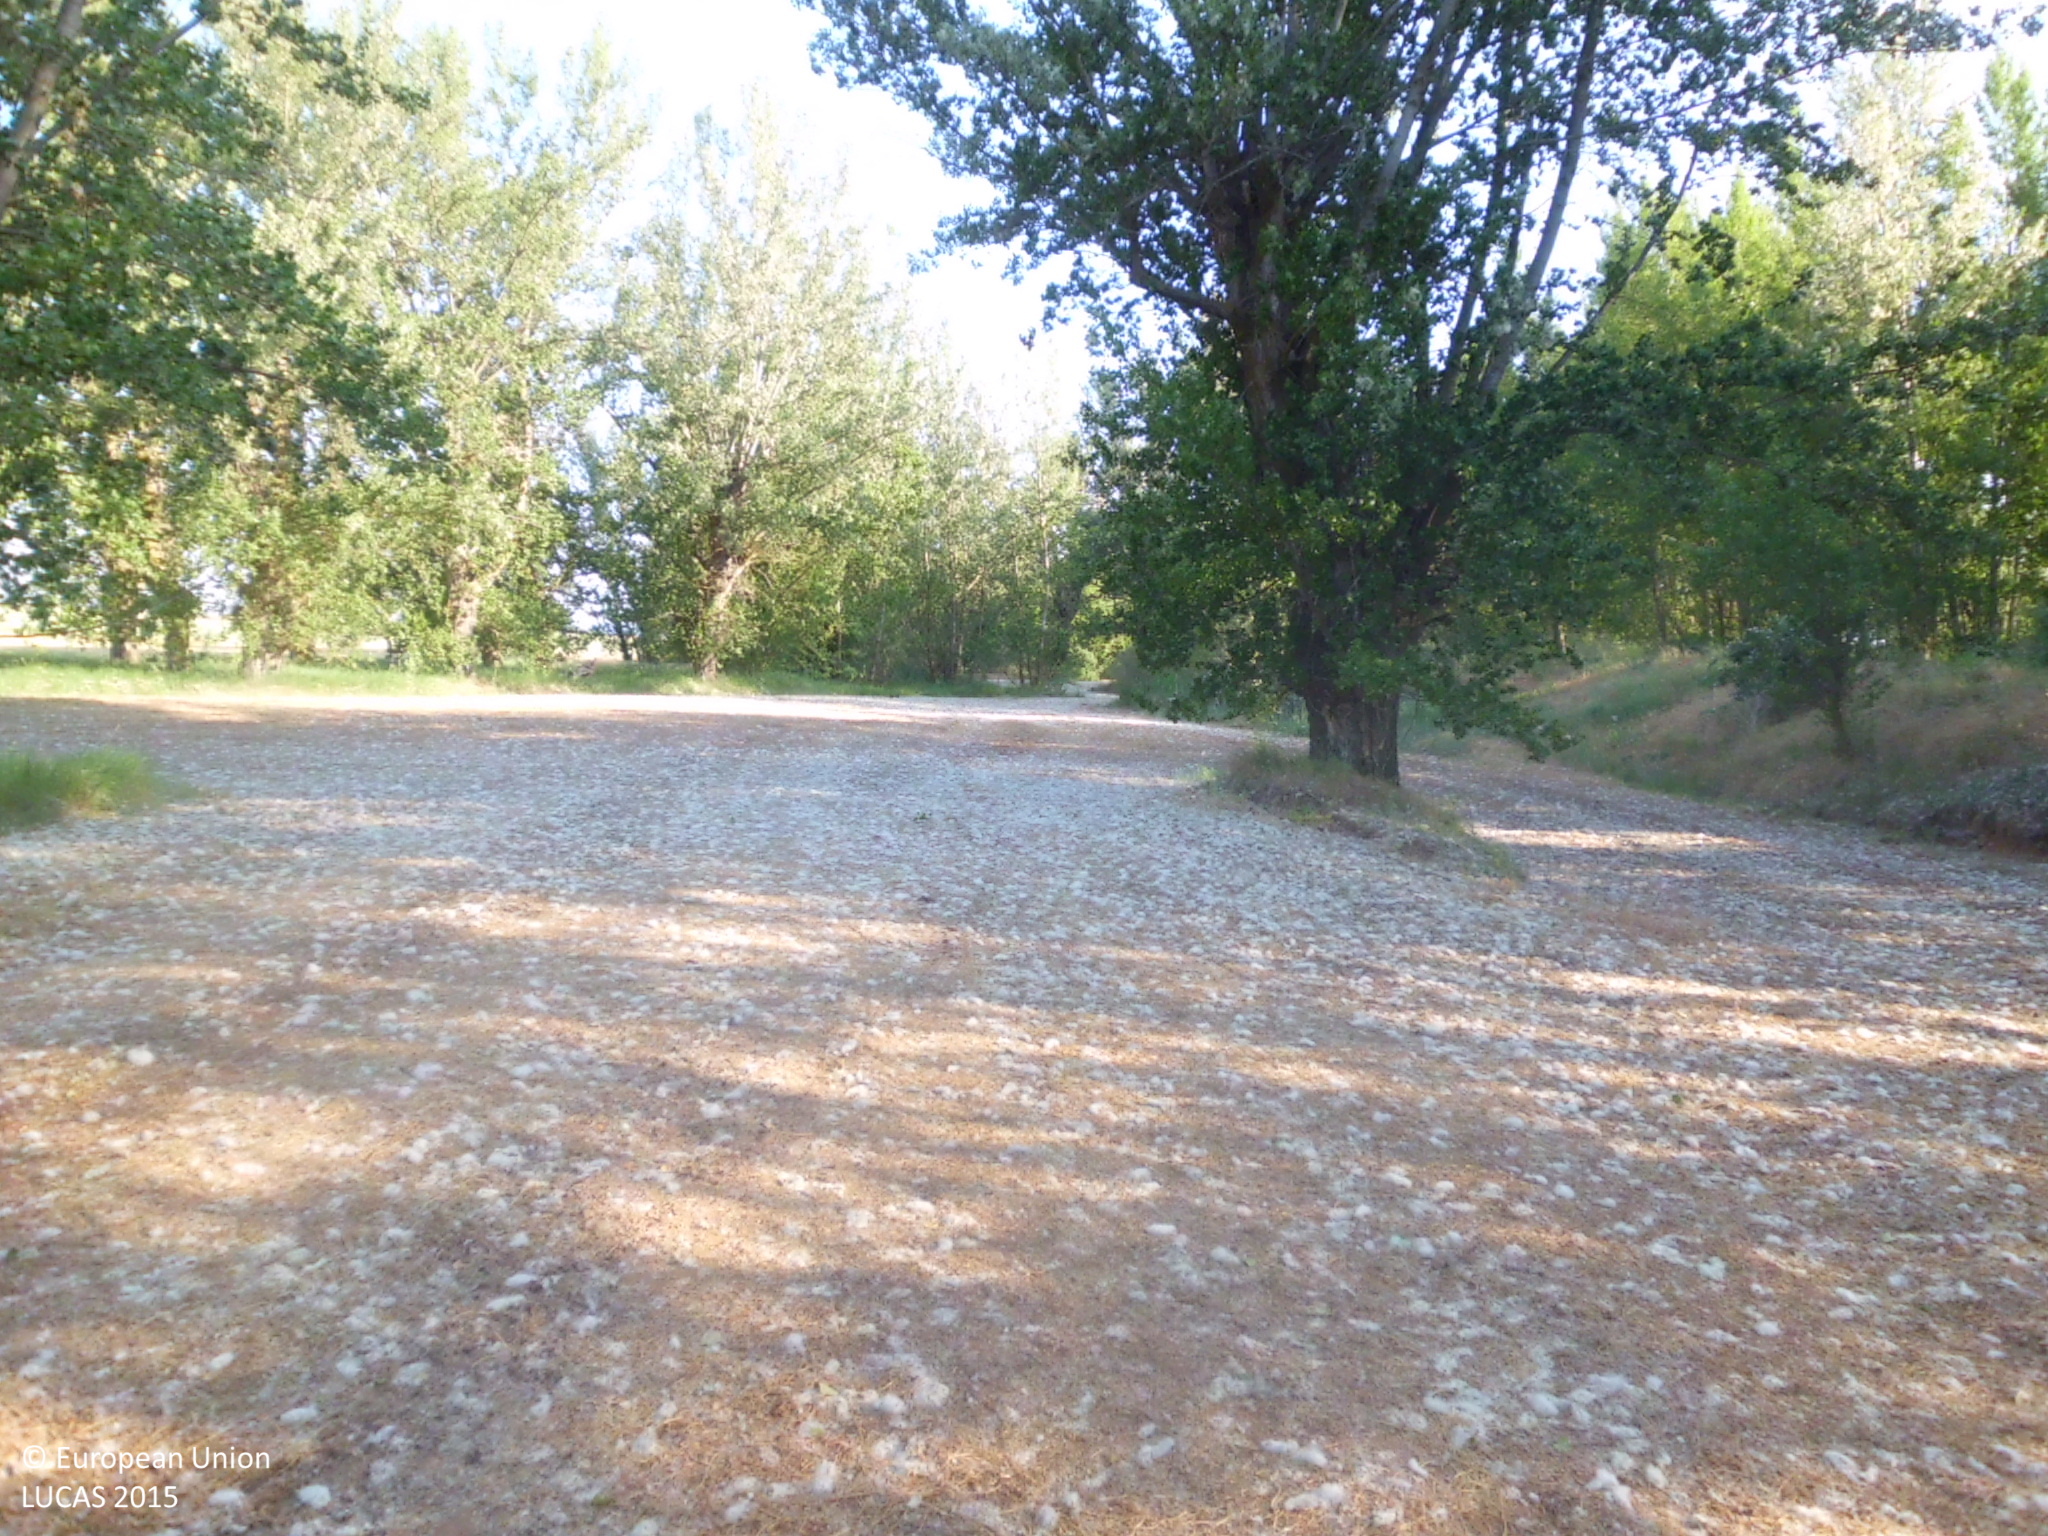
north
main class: Cropland
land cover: Mixed cereals for fodder
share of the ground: 50 - 75 %
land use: Agriculture (excluding fallow land and kitchen gardens)
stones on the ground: < 10 %
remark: Harvested field
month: June
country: ES
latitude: 42.4787
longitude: -4.0196
